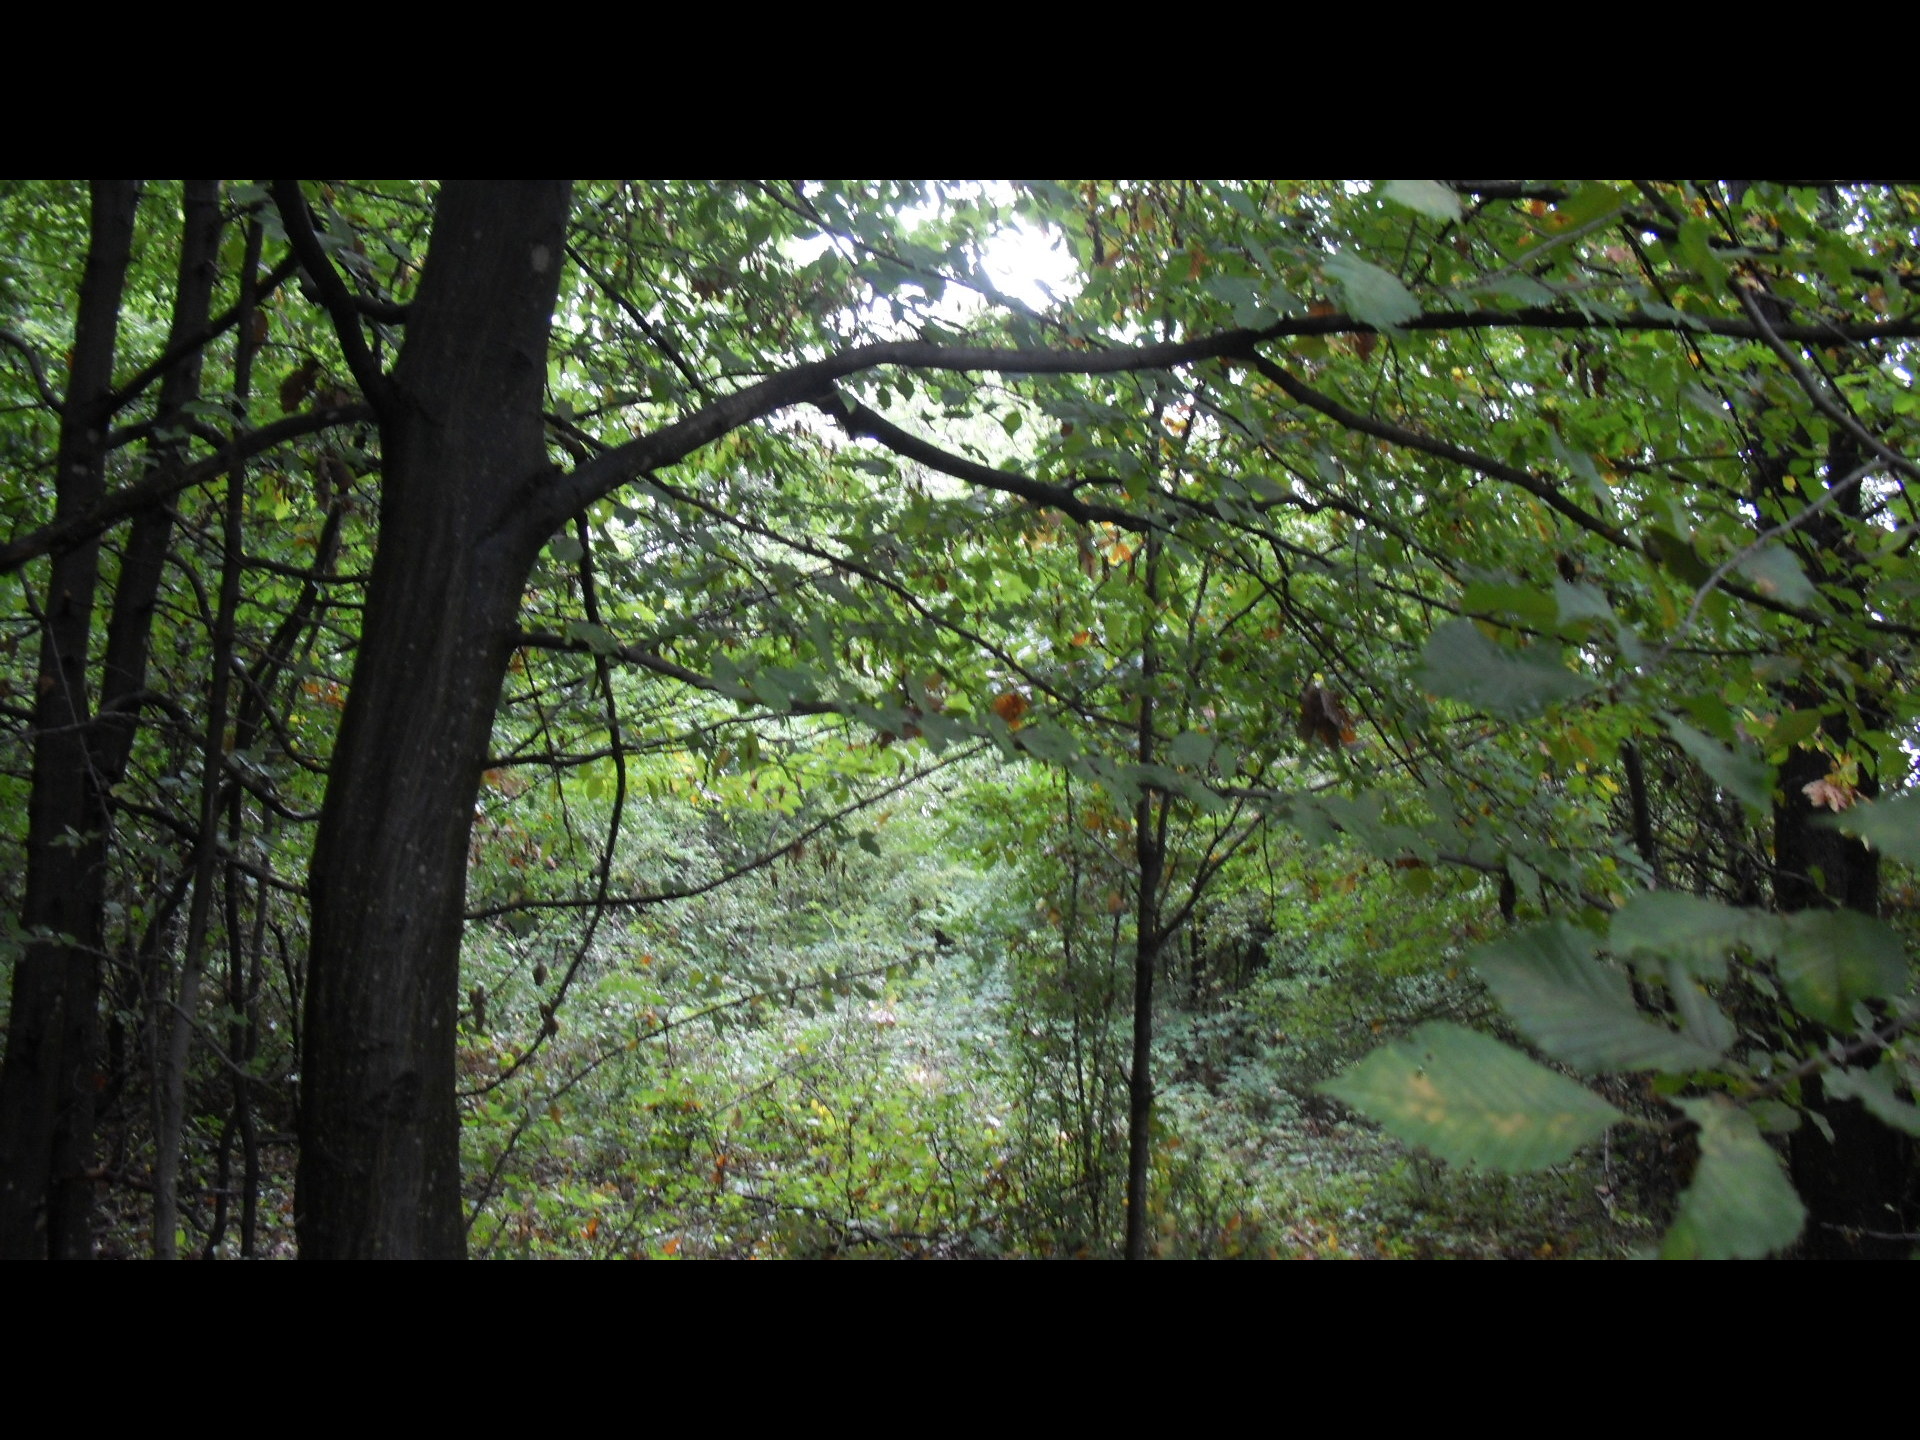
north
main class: Woodland
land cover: Broadleaved woodland
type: mesophytic deciduous forest
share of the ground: > 75 %
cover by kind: broadleaved forest trees 90 %, unconsolidated bare surface 10 %
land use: Forestry
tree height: > 5 m
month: October
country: BG
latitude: 43.4566
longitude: 22.8506
